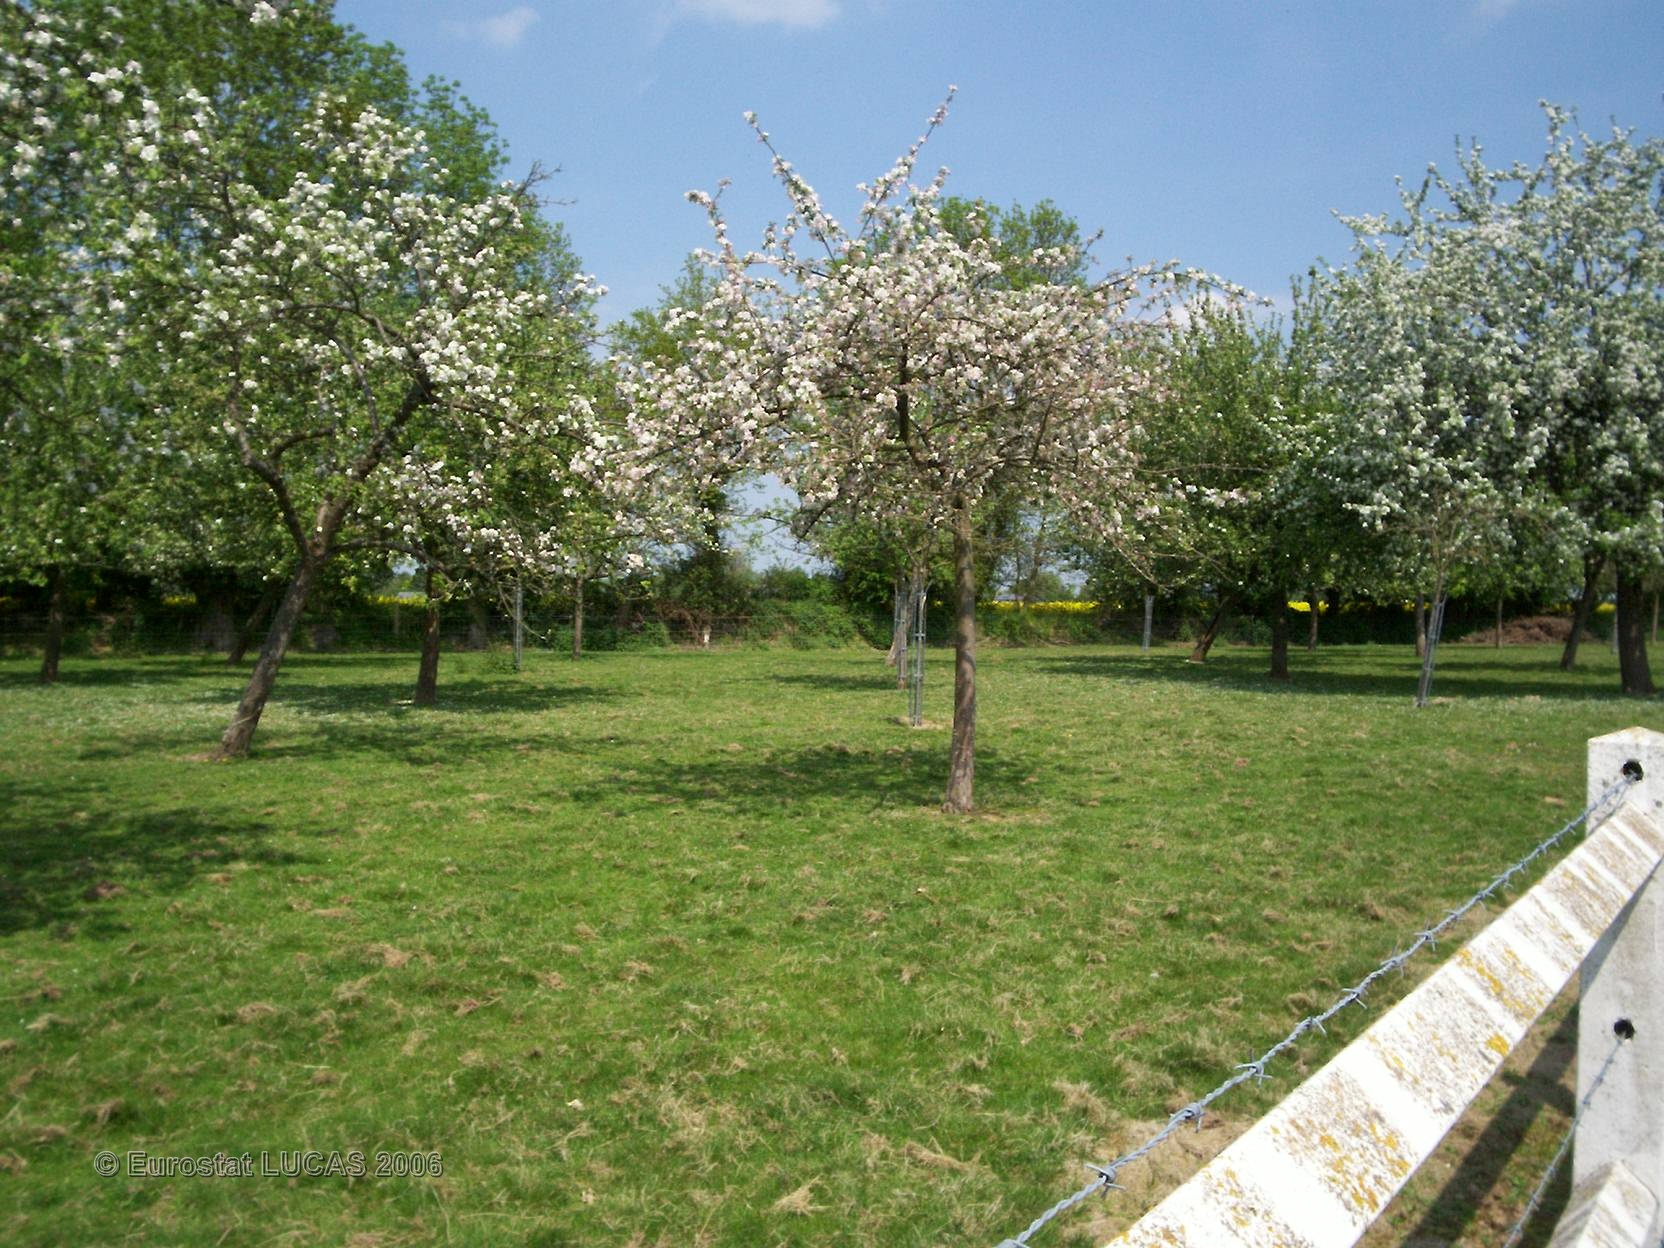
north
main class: Grassland
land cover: Grassland with sparse tree/shrub cover
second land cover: Apple fruit
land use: Agriculture (excluding fallow land and kitchen gardens)
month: May
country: FR
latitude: 49.2063
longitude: 0.4891
